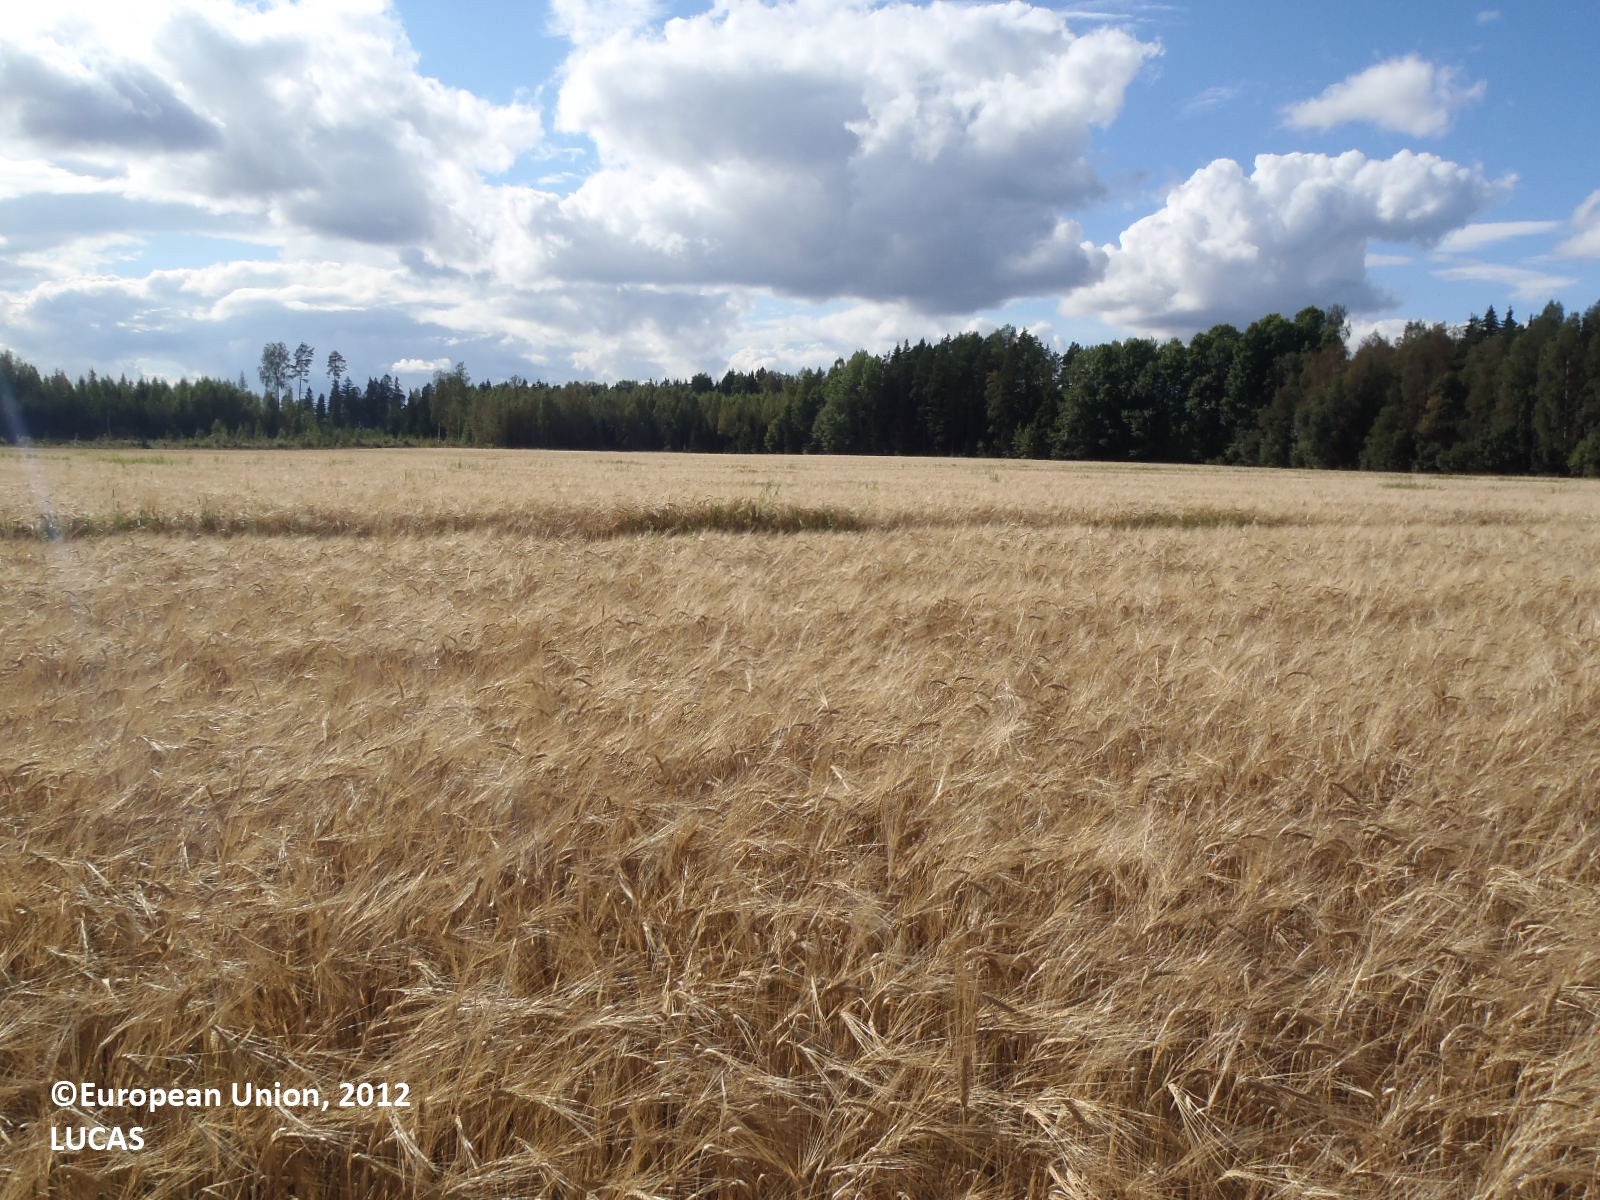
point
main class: Cropland
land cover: Barley
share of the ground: > 75 %
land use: Agriculture (excluding fallow land and kitchen gardens)
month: August
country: FI
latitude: 60.6621
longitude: 22.7156
